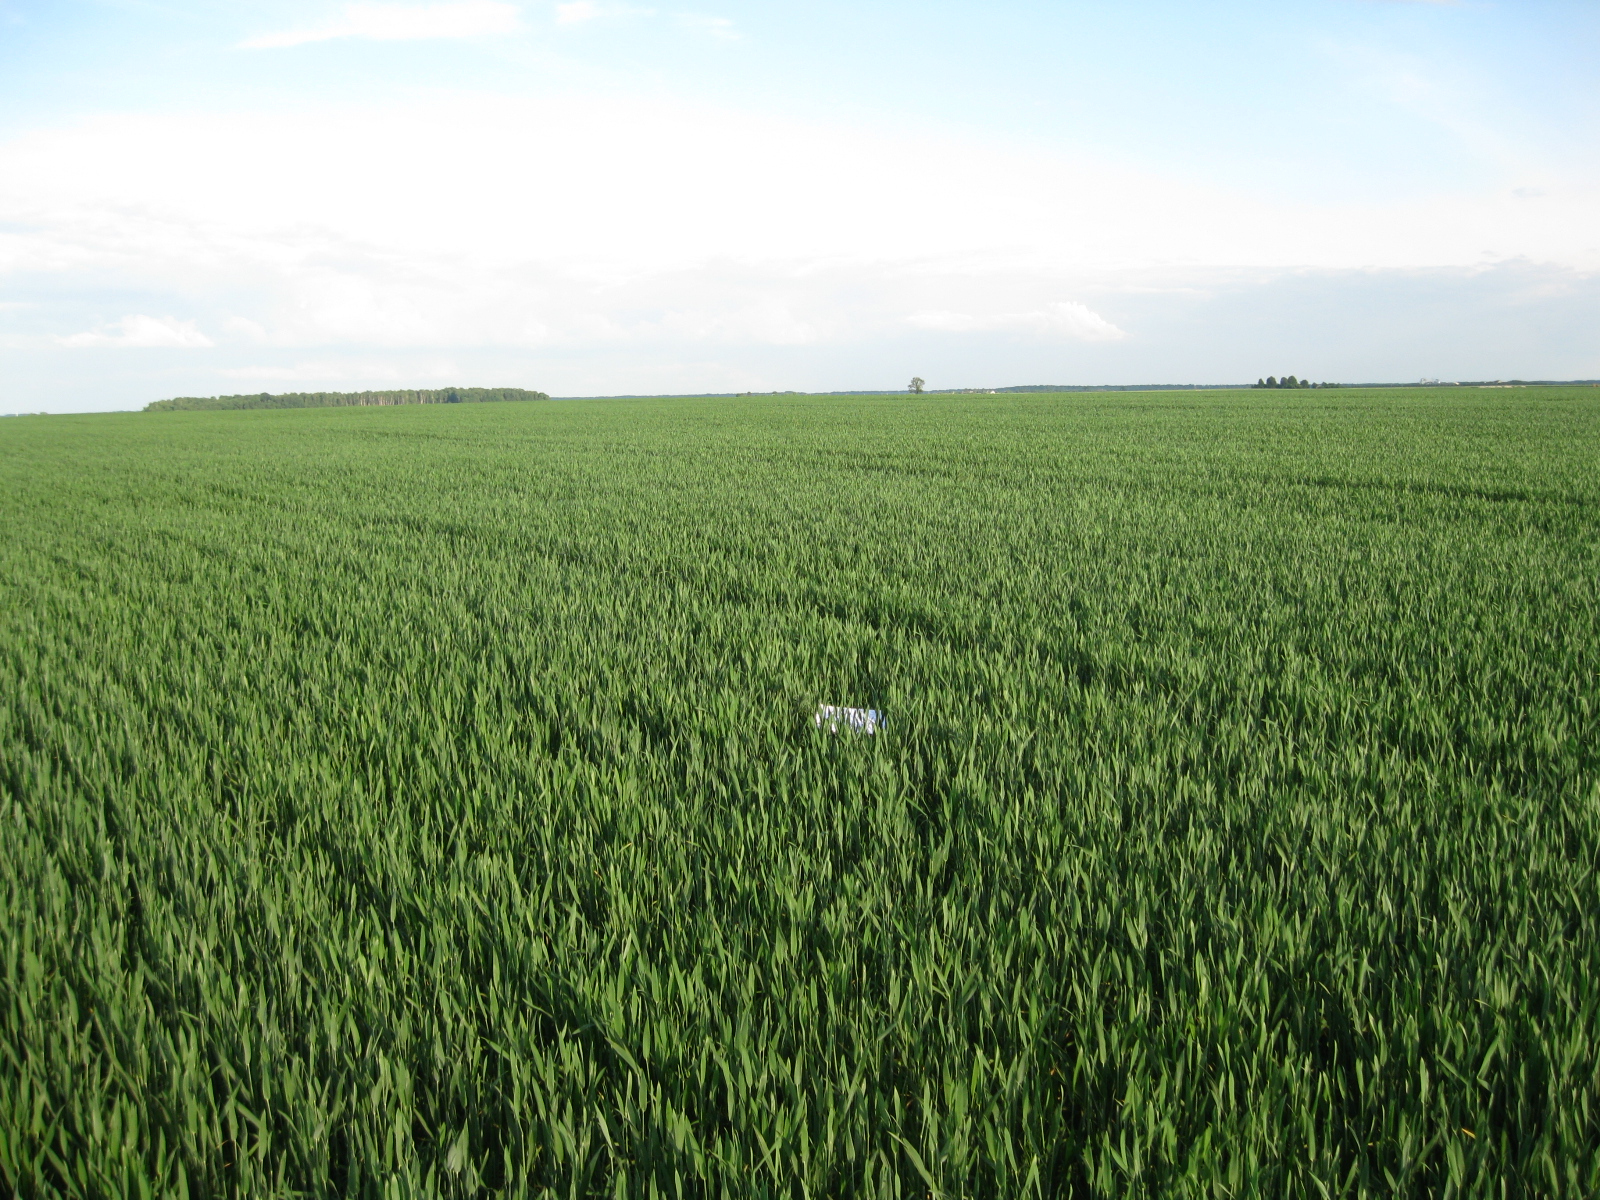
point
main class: Cropland
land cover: Common wheat
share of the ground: > 75 %
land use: Agriculture (excluding fallow land and kitchen gardens)
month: June
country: LT
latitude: 55.1575
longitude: 23.8514
